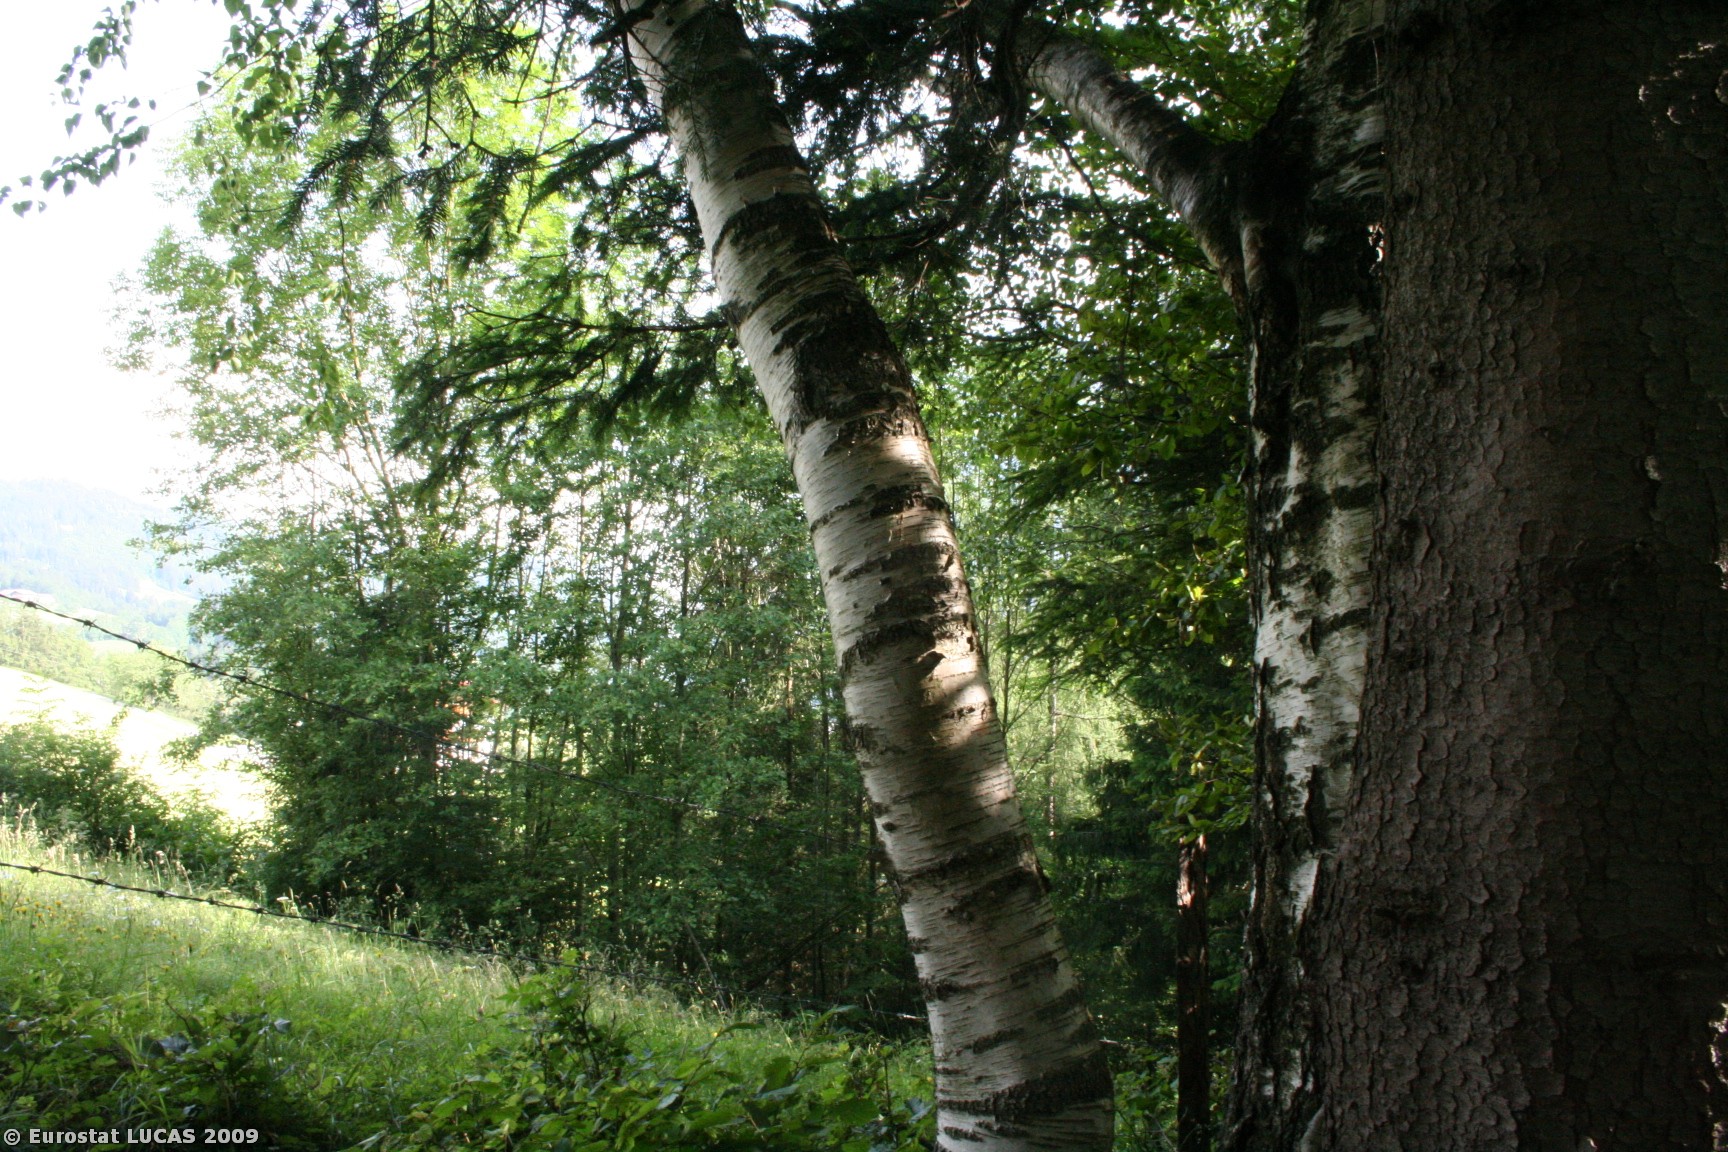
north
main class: Woodland
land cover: Broadleaved woodland
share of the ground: 50 - 75 %
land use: Forestry
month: June
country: AT
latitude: 47.4568
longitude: 13.1950
